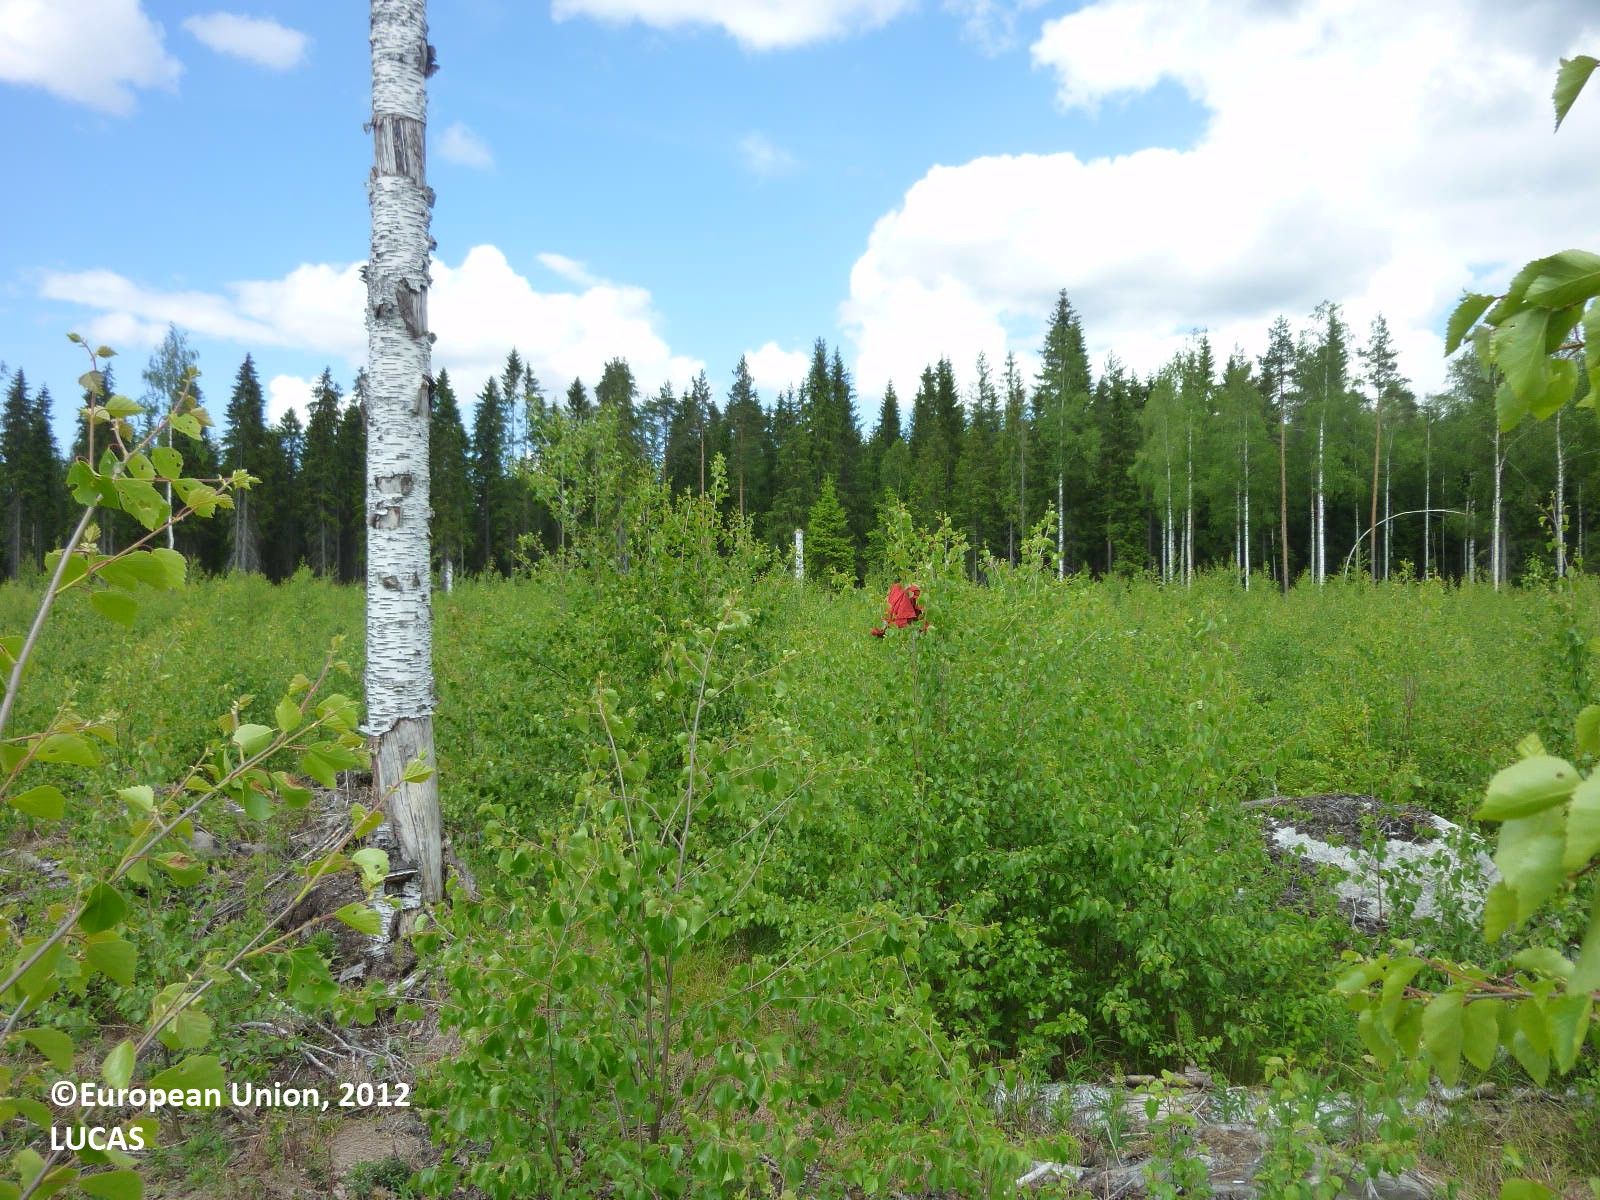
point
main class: Woodland
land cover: Broadleaved woodland
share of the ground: 50 - 75 %
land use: Forestry
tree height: > 5 m
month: June
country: FI
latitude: 61.4459
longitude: 22.5358
